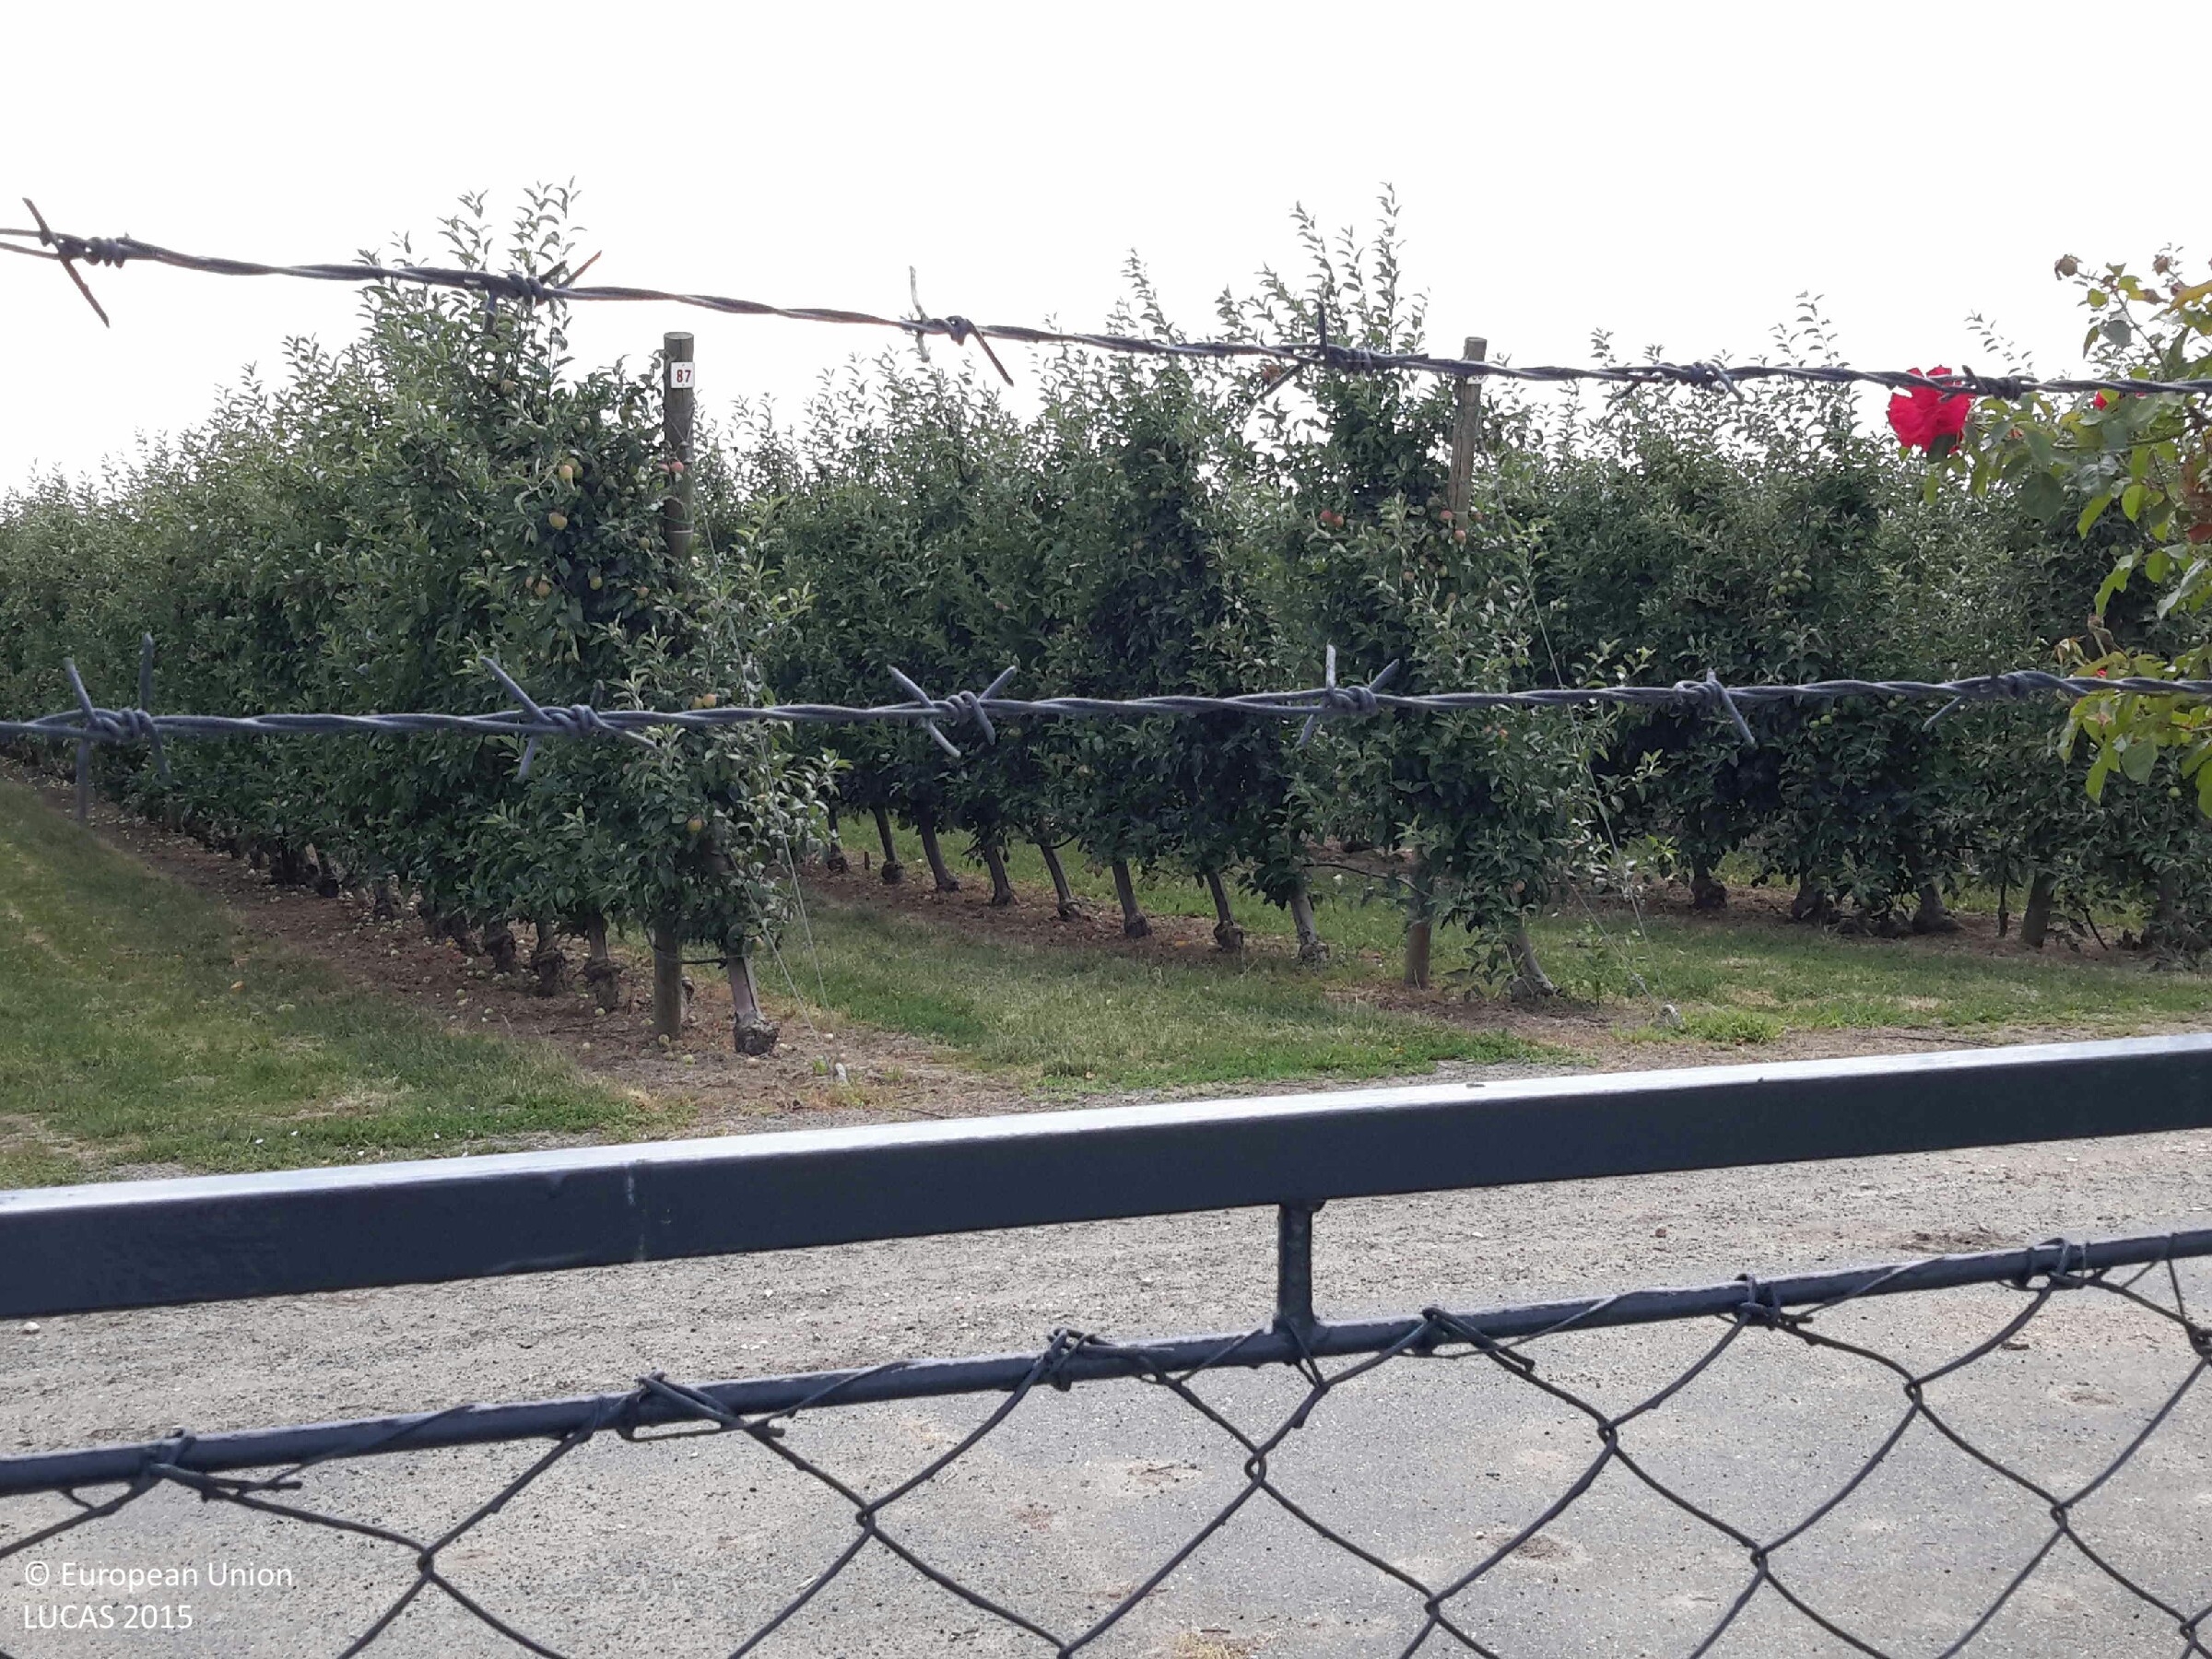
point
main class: Cropland
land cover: Apple fruit
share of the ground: 25 - 50 %
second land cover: Grassland without tree/shrub cover
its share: 50 - 75 %
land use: Agriculture (excluding fallow land and kitchen gardens)
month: July
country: HU
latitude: 47.5350
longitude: 17.2200
